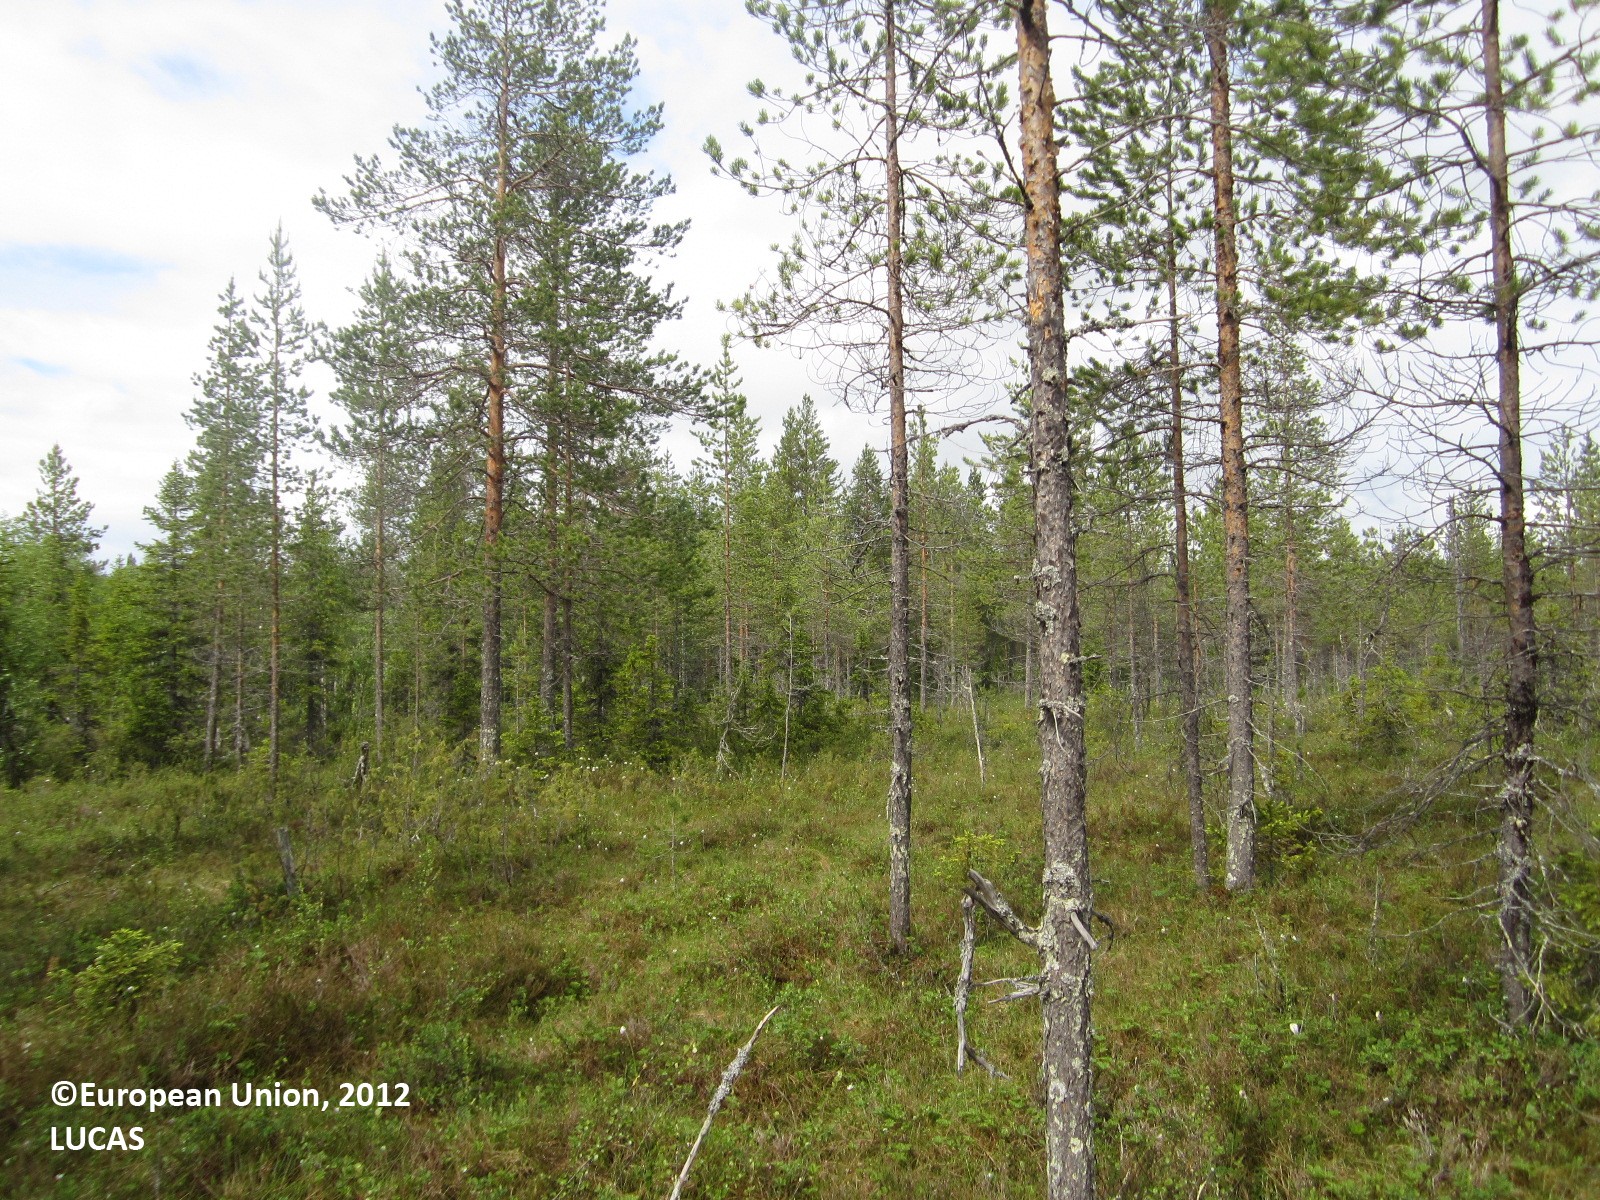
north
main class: Woodland
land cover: Pine dominated coniferous woodland
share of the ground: 10 - 25 %
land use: Semi-natural and natural areas not in use
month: June
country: FI
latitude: 64.6393
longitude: 29.8752
